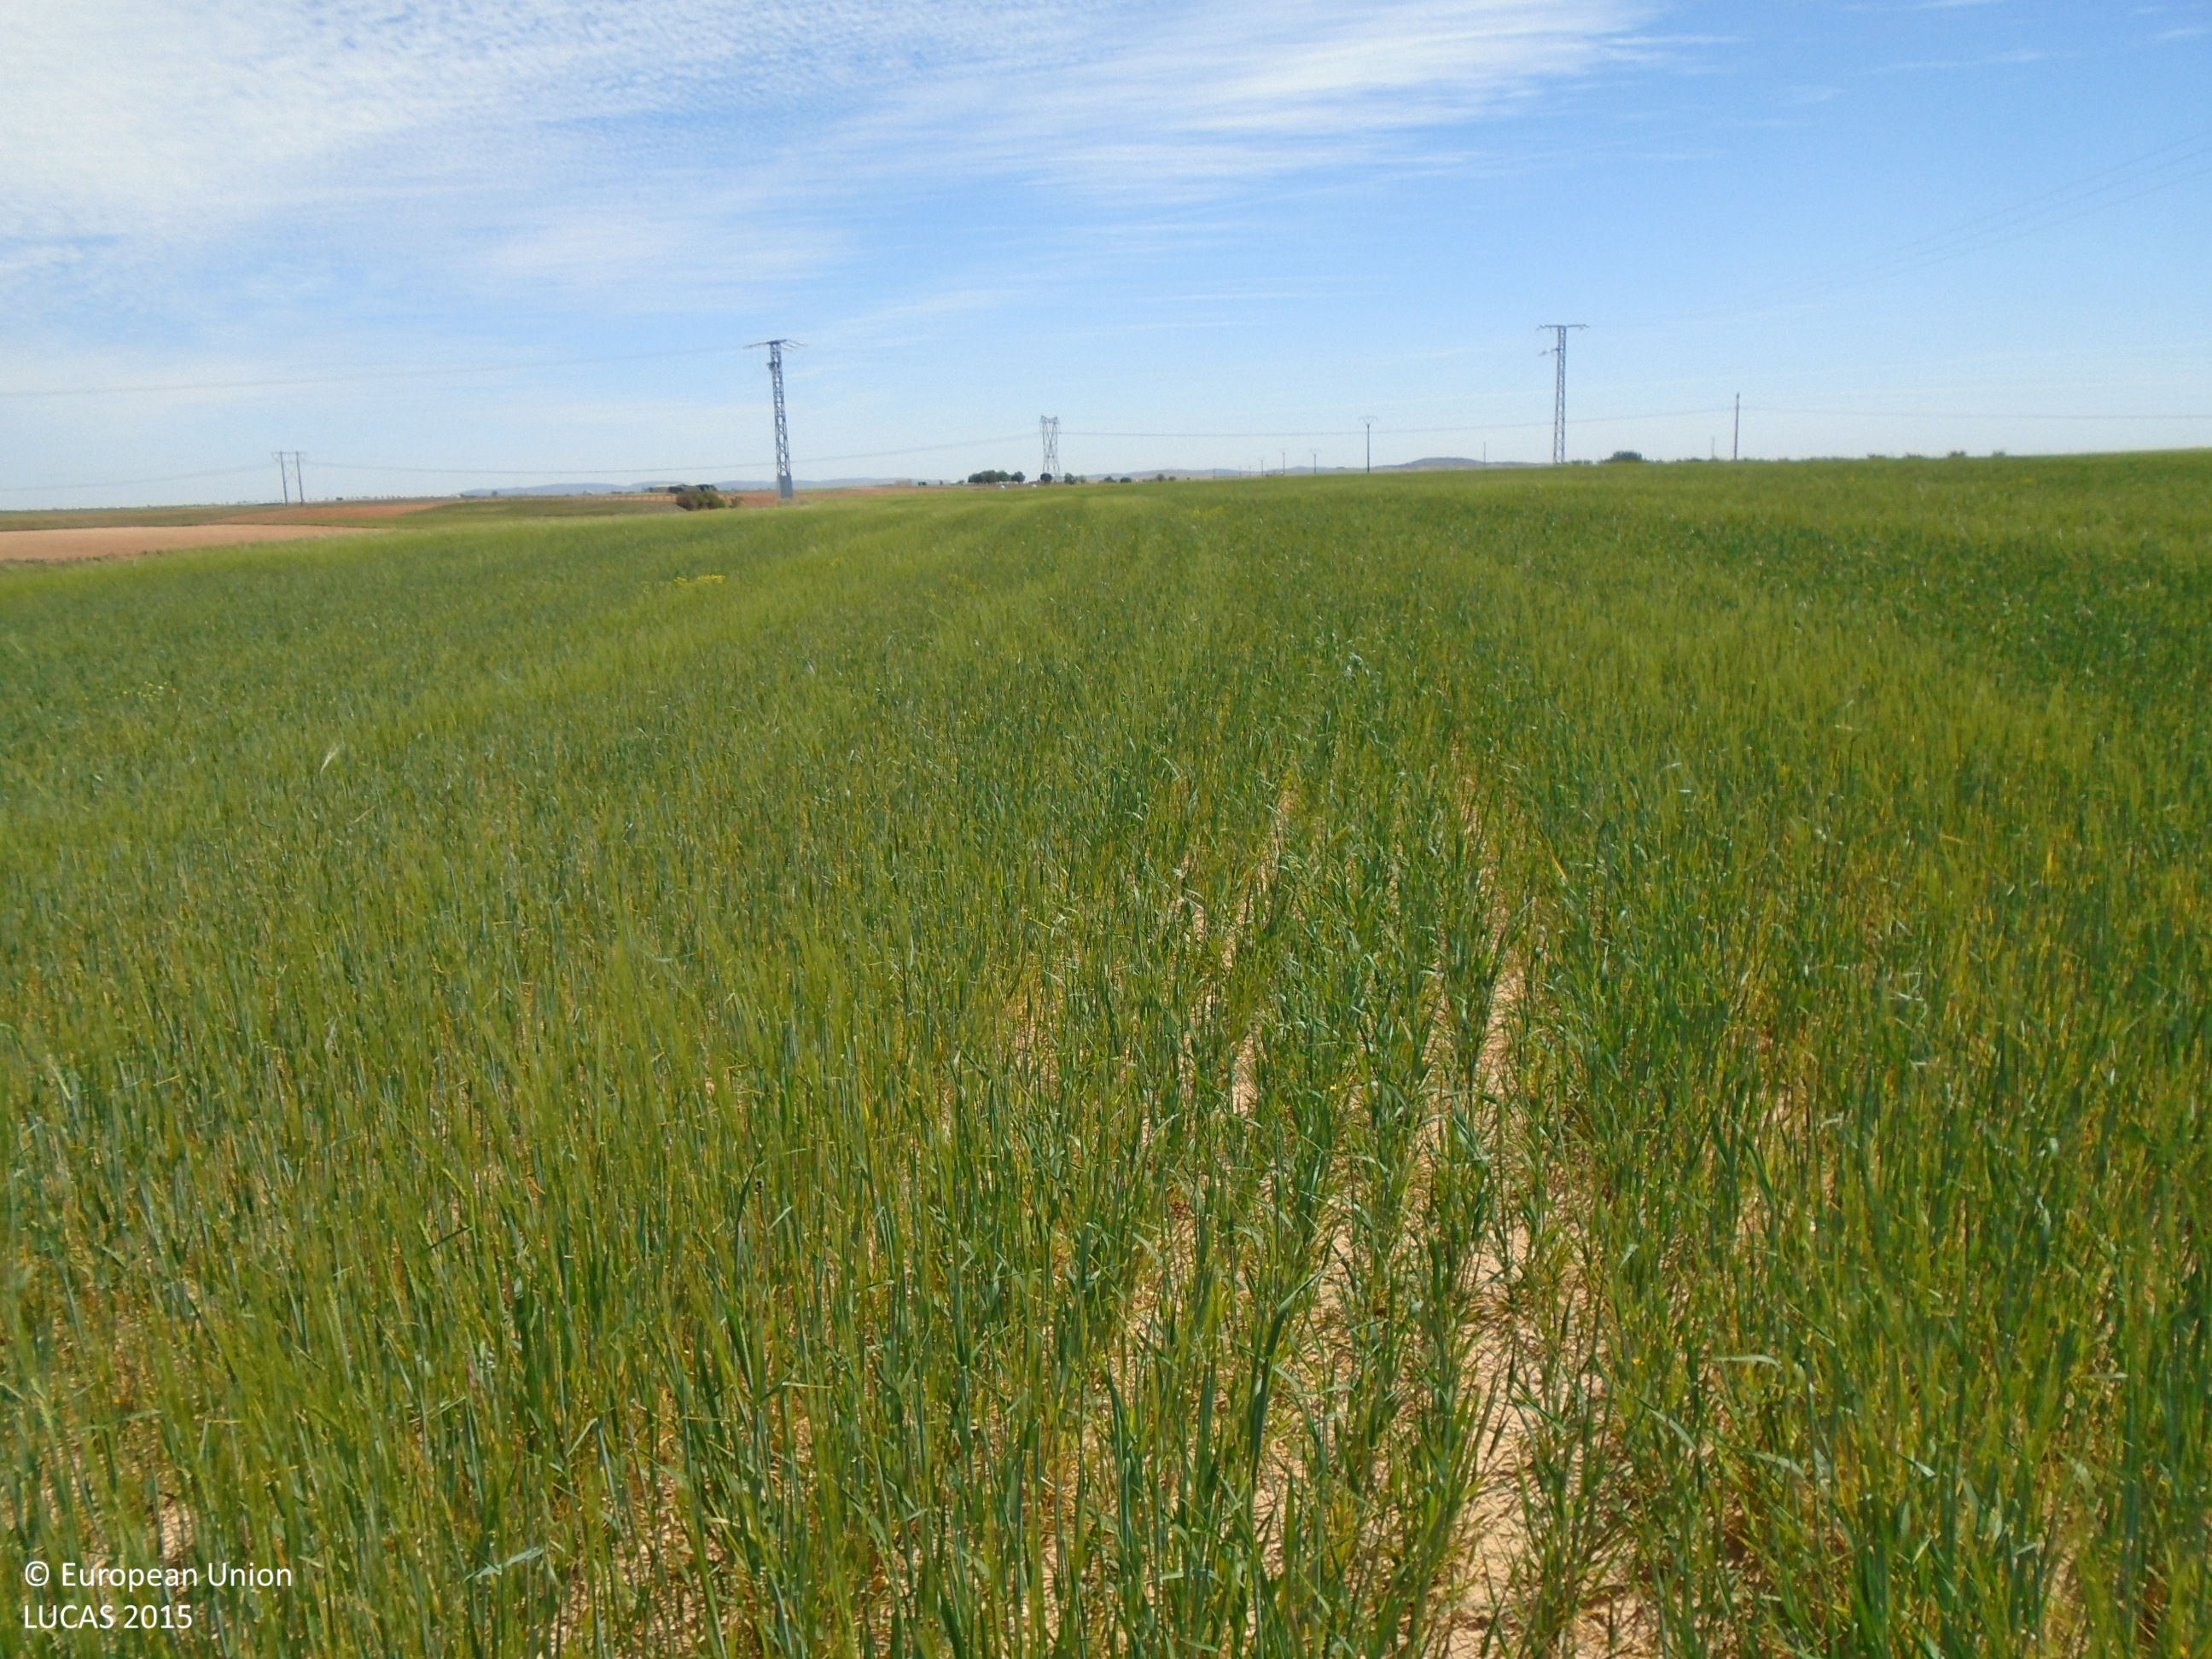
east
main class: Cropland
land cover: Barley
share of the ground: > 75 %
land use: Agriculture (excluding fallow land and kitchen gardens)
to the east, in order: Barley; Electric lines; Barley; Grass margins; Other bare soil; Grass margins; Barley; Grass margins; Barley
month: May
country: ES
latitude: 39.6029
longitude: -3.6401
